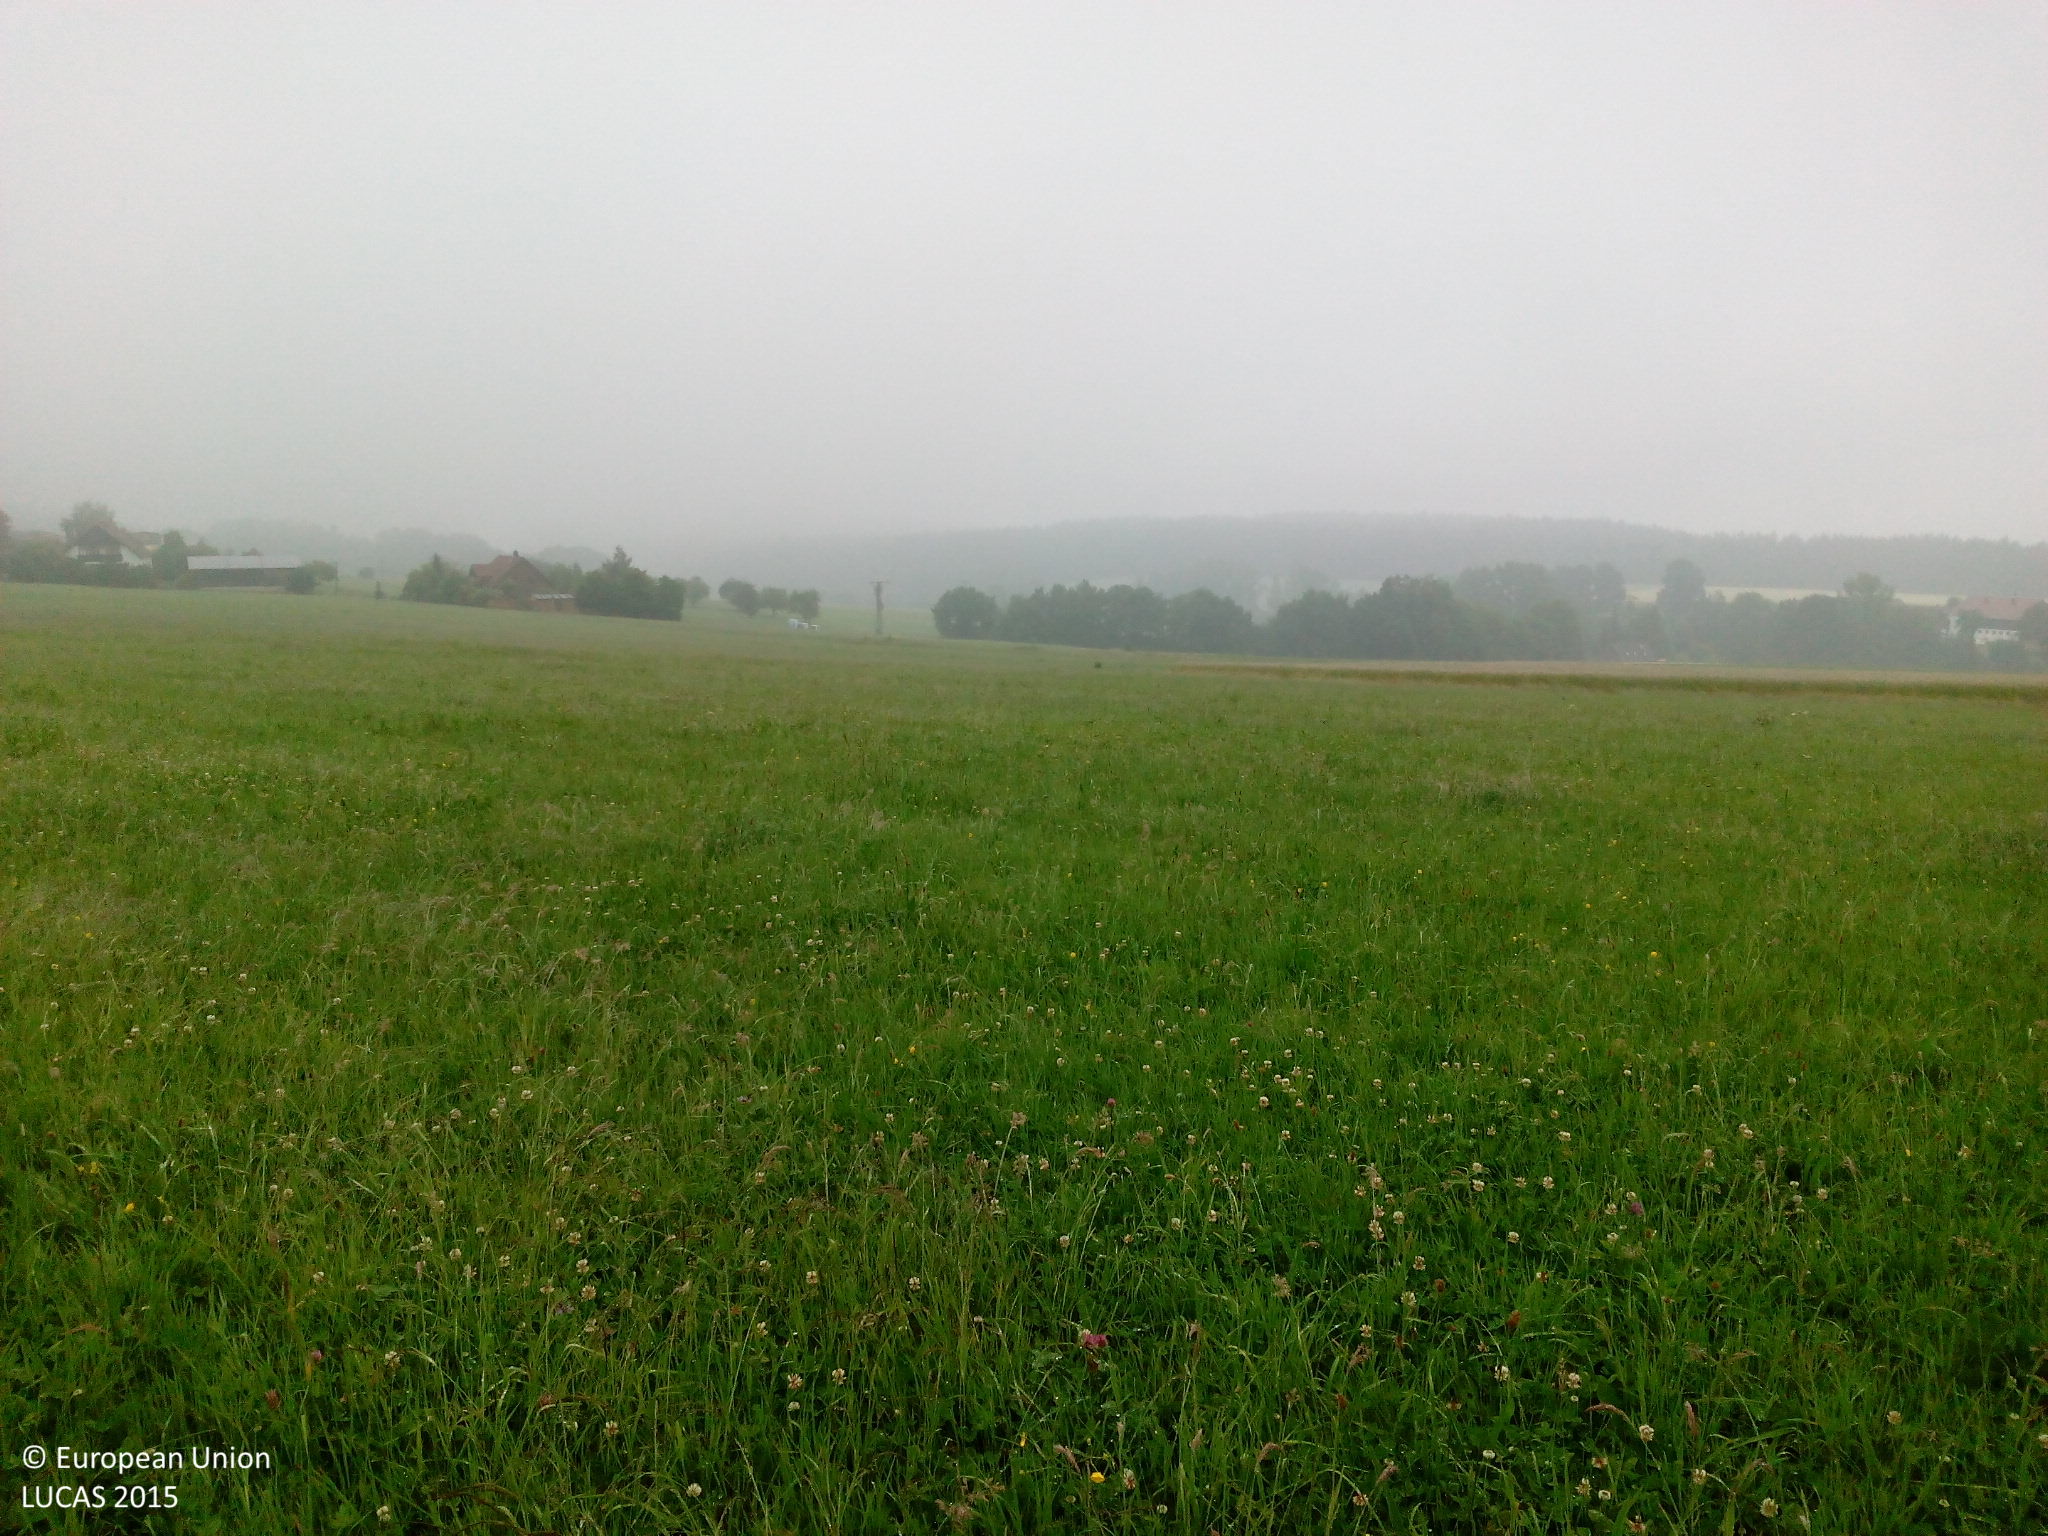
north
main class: Grassland
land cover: Grassland without tree/shrub cover
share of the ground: > 75 %
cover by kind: herbaceous plants 100 %
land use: Agriculture (excluding fallow land and kitchen gardens)
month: June
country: DE
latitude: 50.0845
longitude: 11.4950
